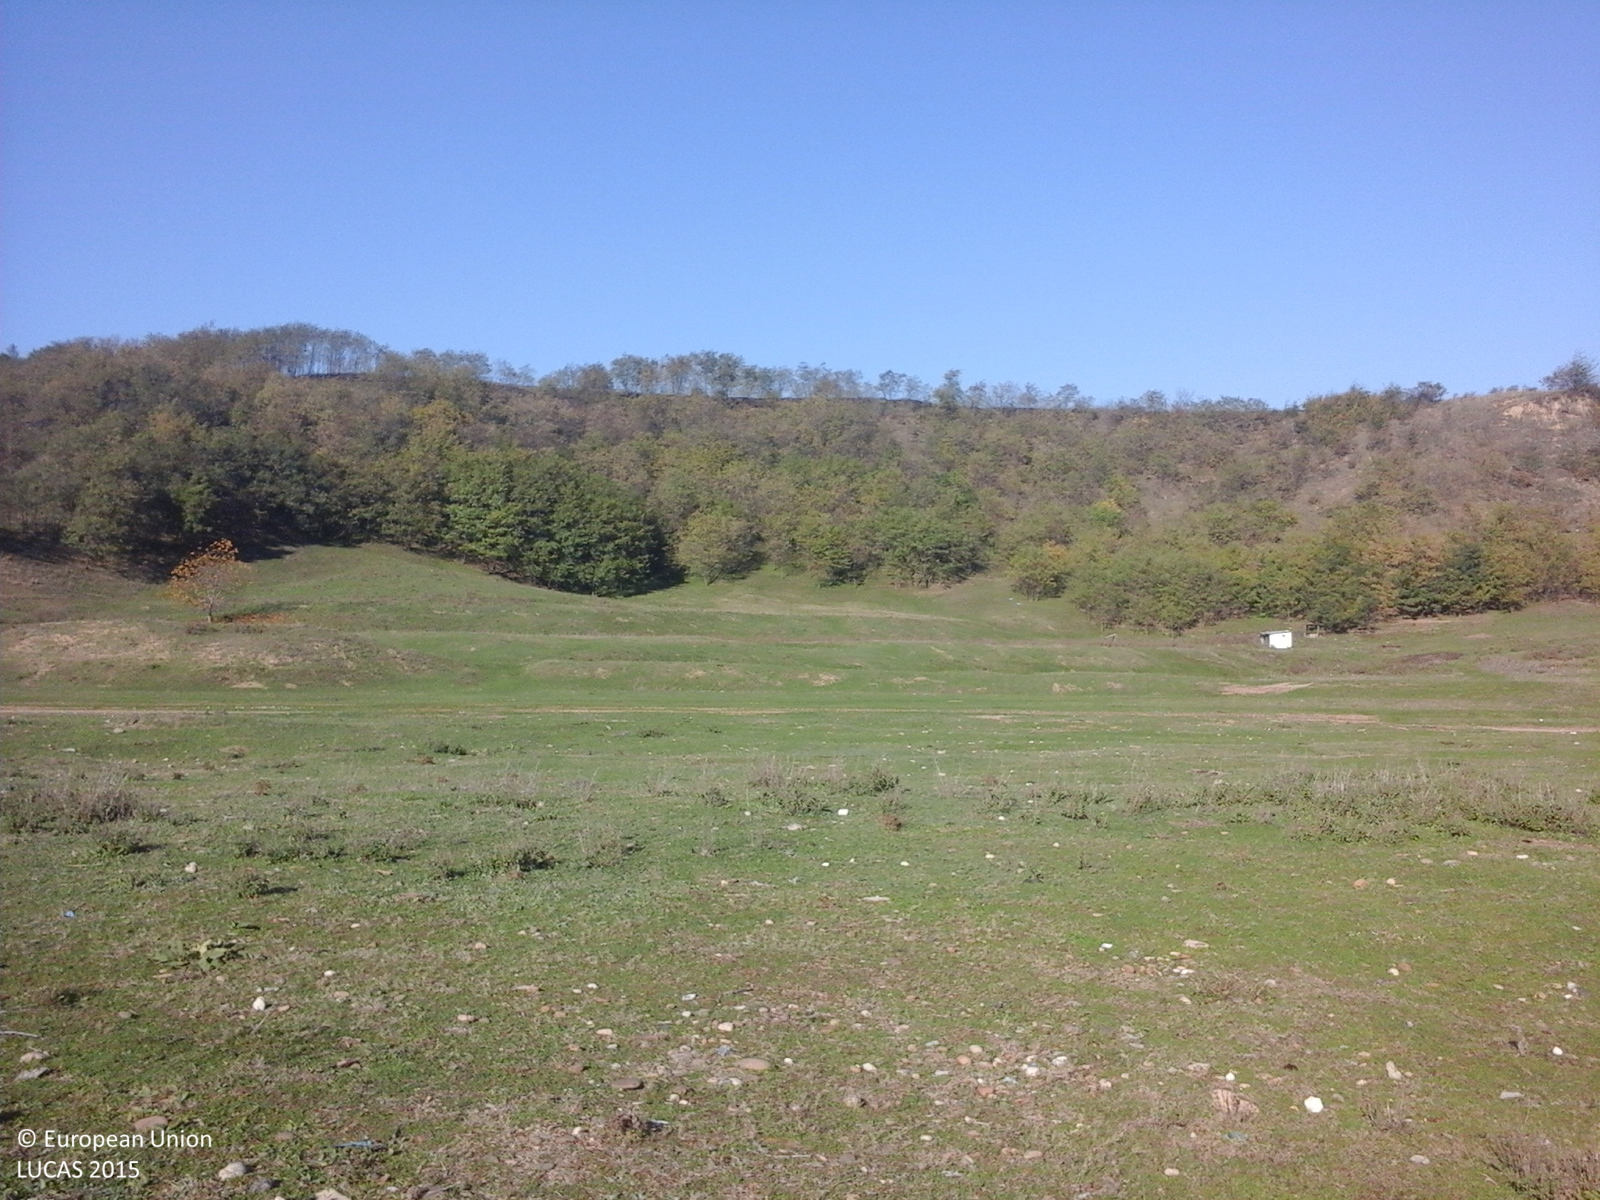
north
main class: Grassland
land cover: Spontaneously vegetated surfaces
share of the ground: > 75 %
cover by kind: herbaceous plants 100 %
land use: Fallow land
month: October
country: RO
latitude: 46.0789
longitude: 27.1262
